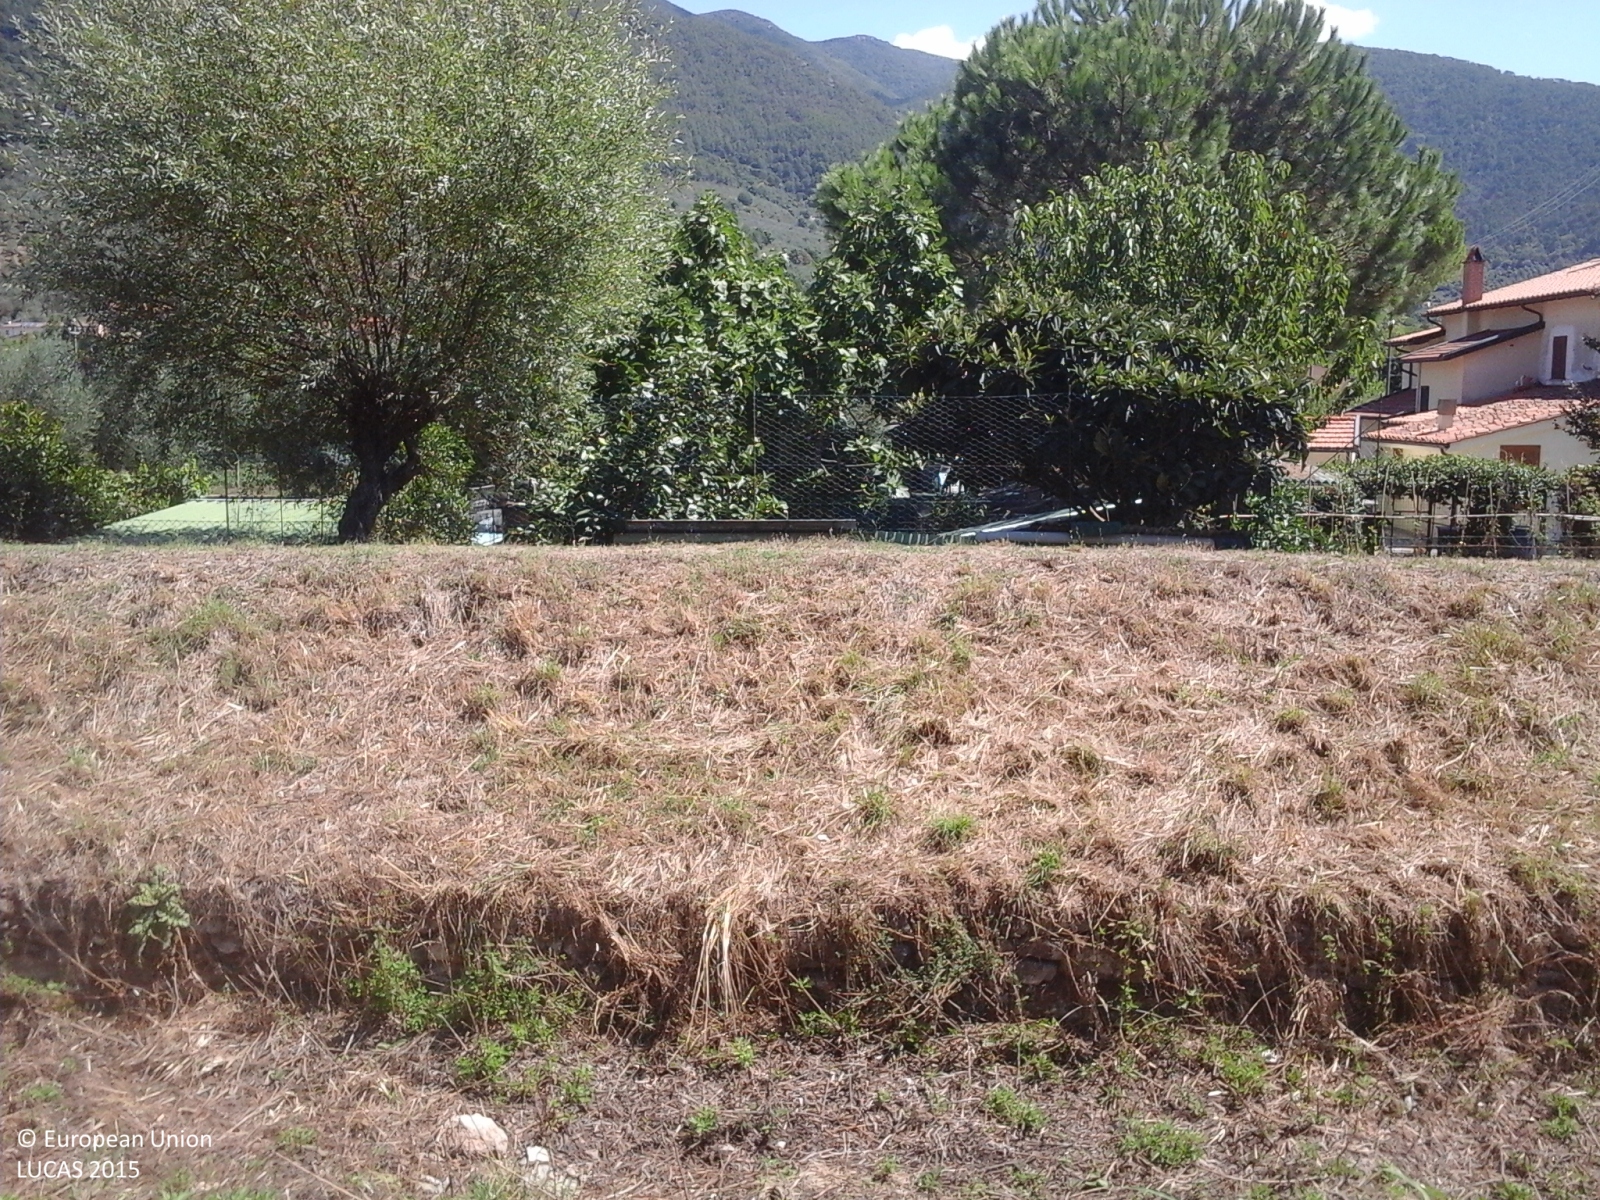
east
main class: Grassland
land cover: Grassland with sparse tree/shrub cover
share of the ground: > 75 %
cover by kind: herbaceous plants 85 %, shrubs 10 %, broadleaved forest trees 5 %
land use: Semi-natural and natural areas not in use
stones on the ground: < 10 %
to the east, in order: Grassland with sparse tree/shrub cover; Ditches and canals; Grassland without tree/shrub cover; Fences; Artificial constructions in urban areas; Other fresh vegetables; Fences; Electric lines; Grassland without tree/shrub cover; Fences; Electric lines; Grassland with sparse tree/shrub cover; Fences; Electric lines; Paved roads, cycling and walking lanes; Fences; Grassland with sparse tree/shrub cover; Abandoned hedges; Ditches and canals; Single bushes/trees; Fences; Other fresh vegetables
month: August
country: IT
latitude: 43.7542
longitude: 10.4583
